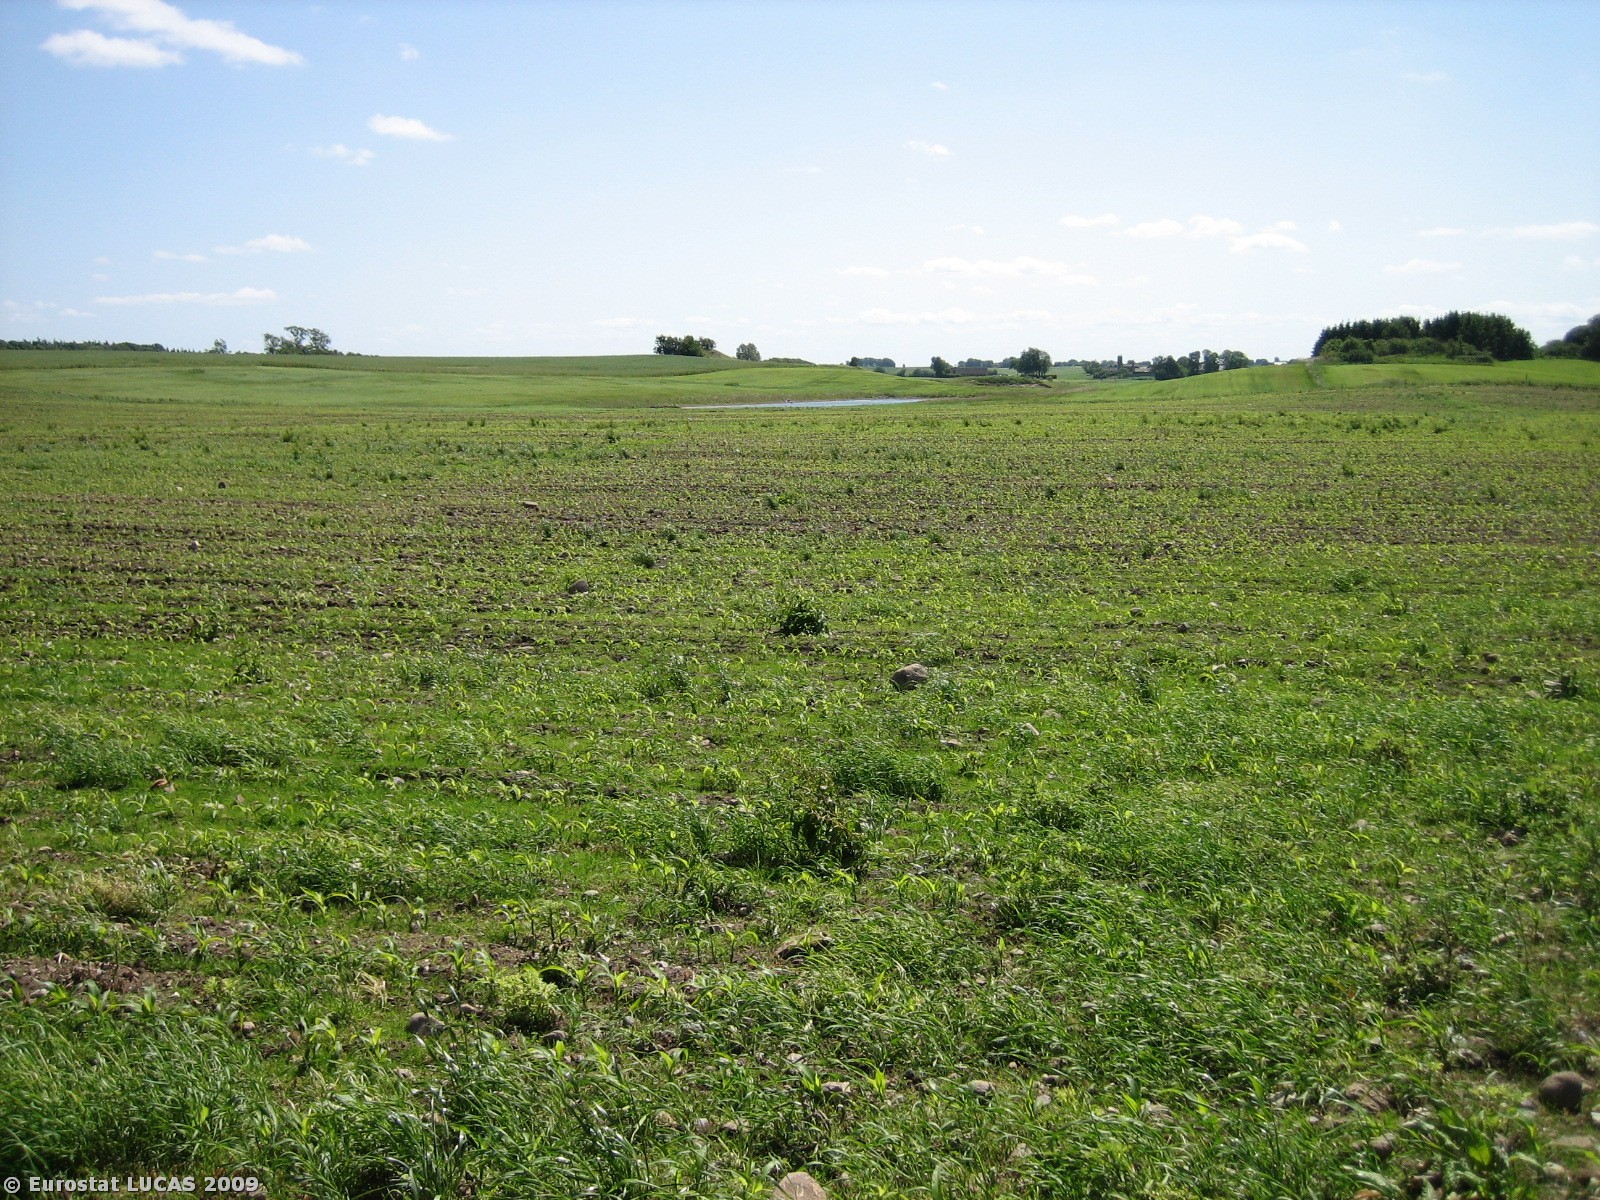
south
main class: Cropland
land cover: Maize
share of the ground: < 10 %
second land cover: Spontaneously vegetated surfaces
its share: 25 - 50 %
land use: Agriculture (excluding fallow land and kitchen gardens)
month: June
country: DK
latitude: 55.9177
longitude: 9.6963
